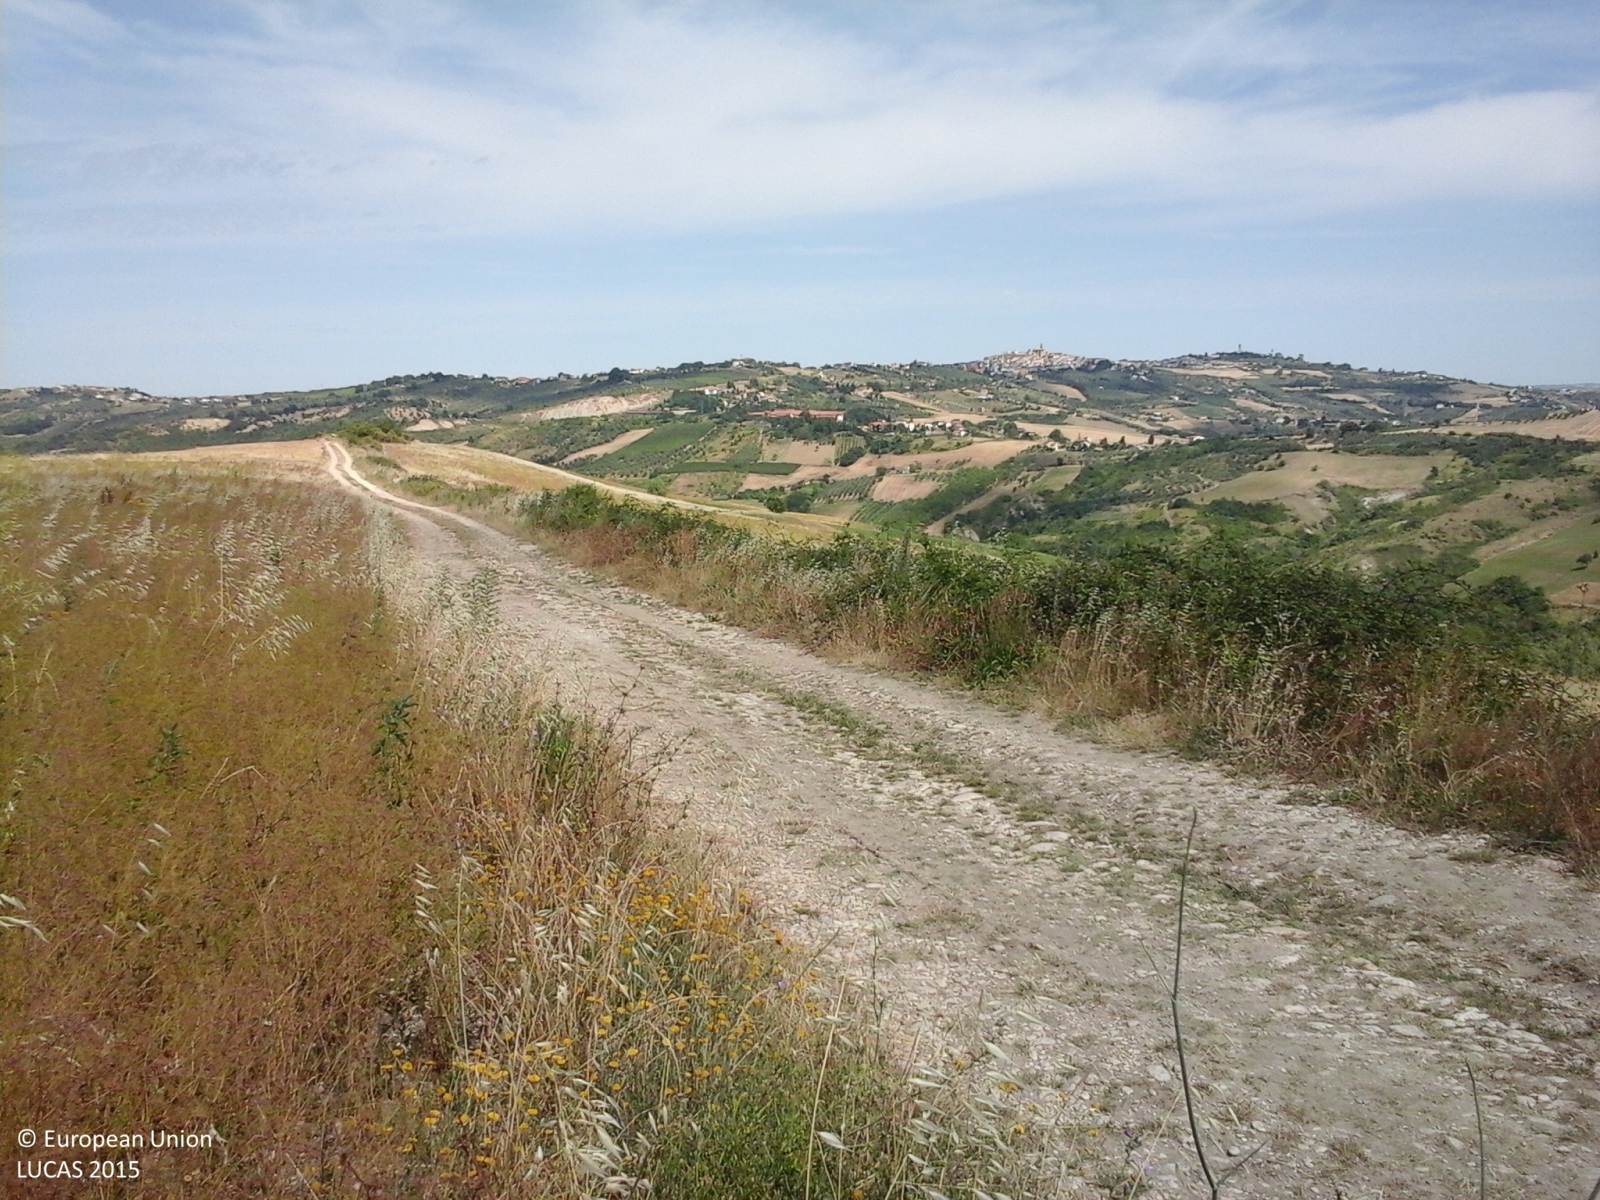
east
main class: Cropland
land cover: Other non-permanent industrial crops
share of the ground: > 75 %
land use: Agriculture (excluding fallow land and kitchen gardens)
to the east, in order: Other non-permanent industrial crops; Tracks; Grassland without tree/shrub cover; Other non-permanent industrial crops
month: June
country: IT
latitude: 42.2006
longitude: 14.3102
